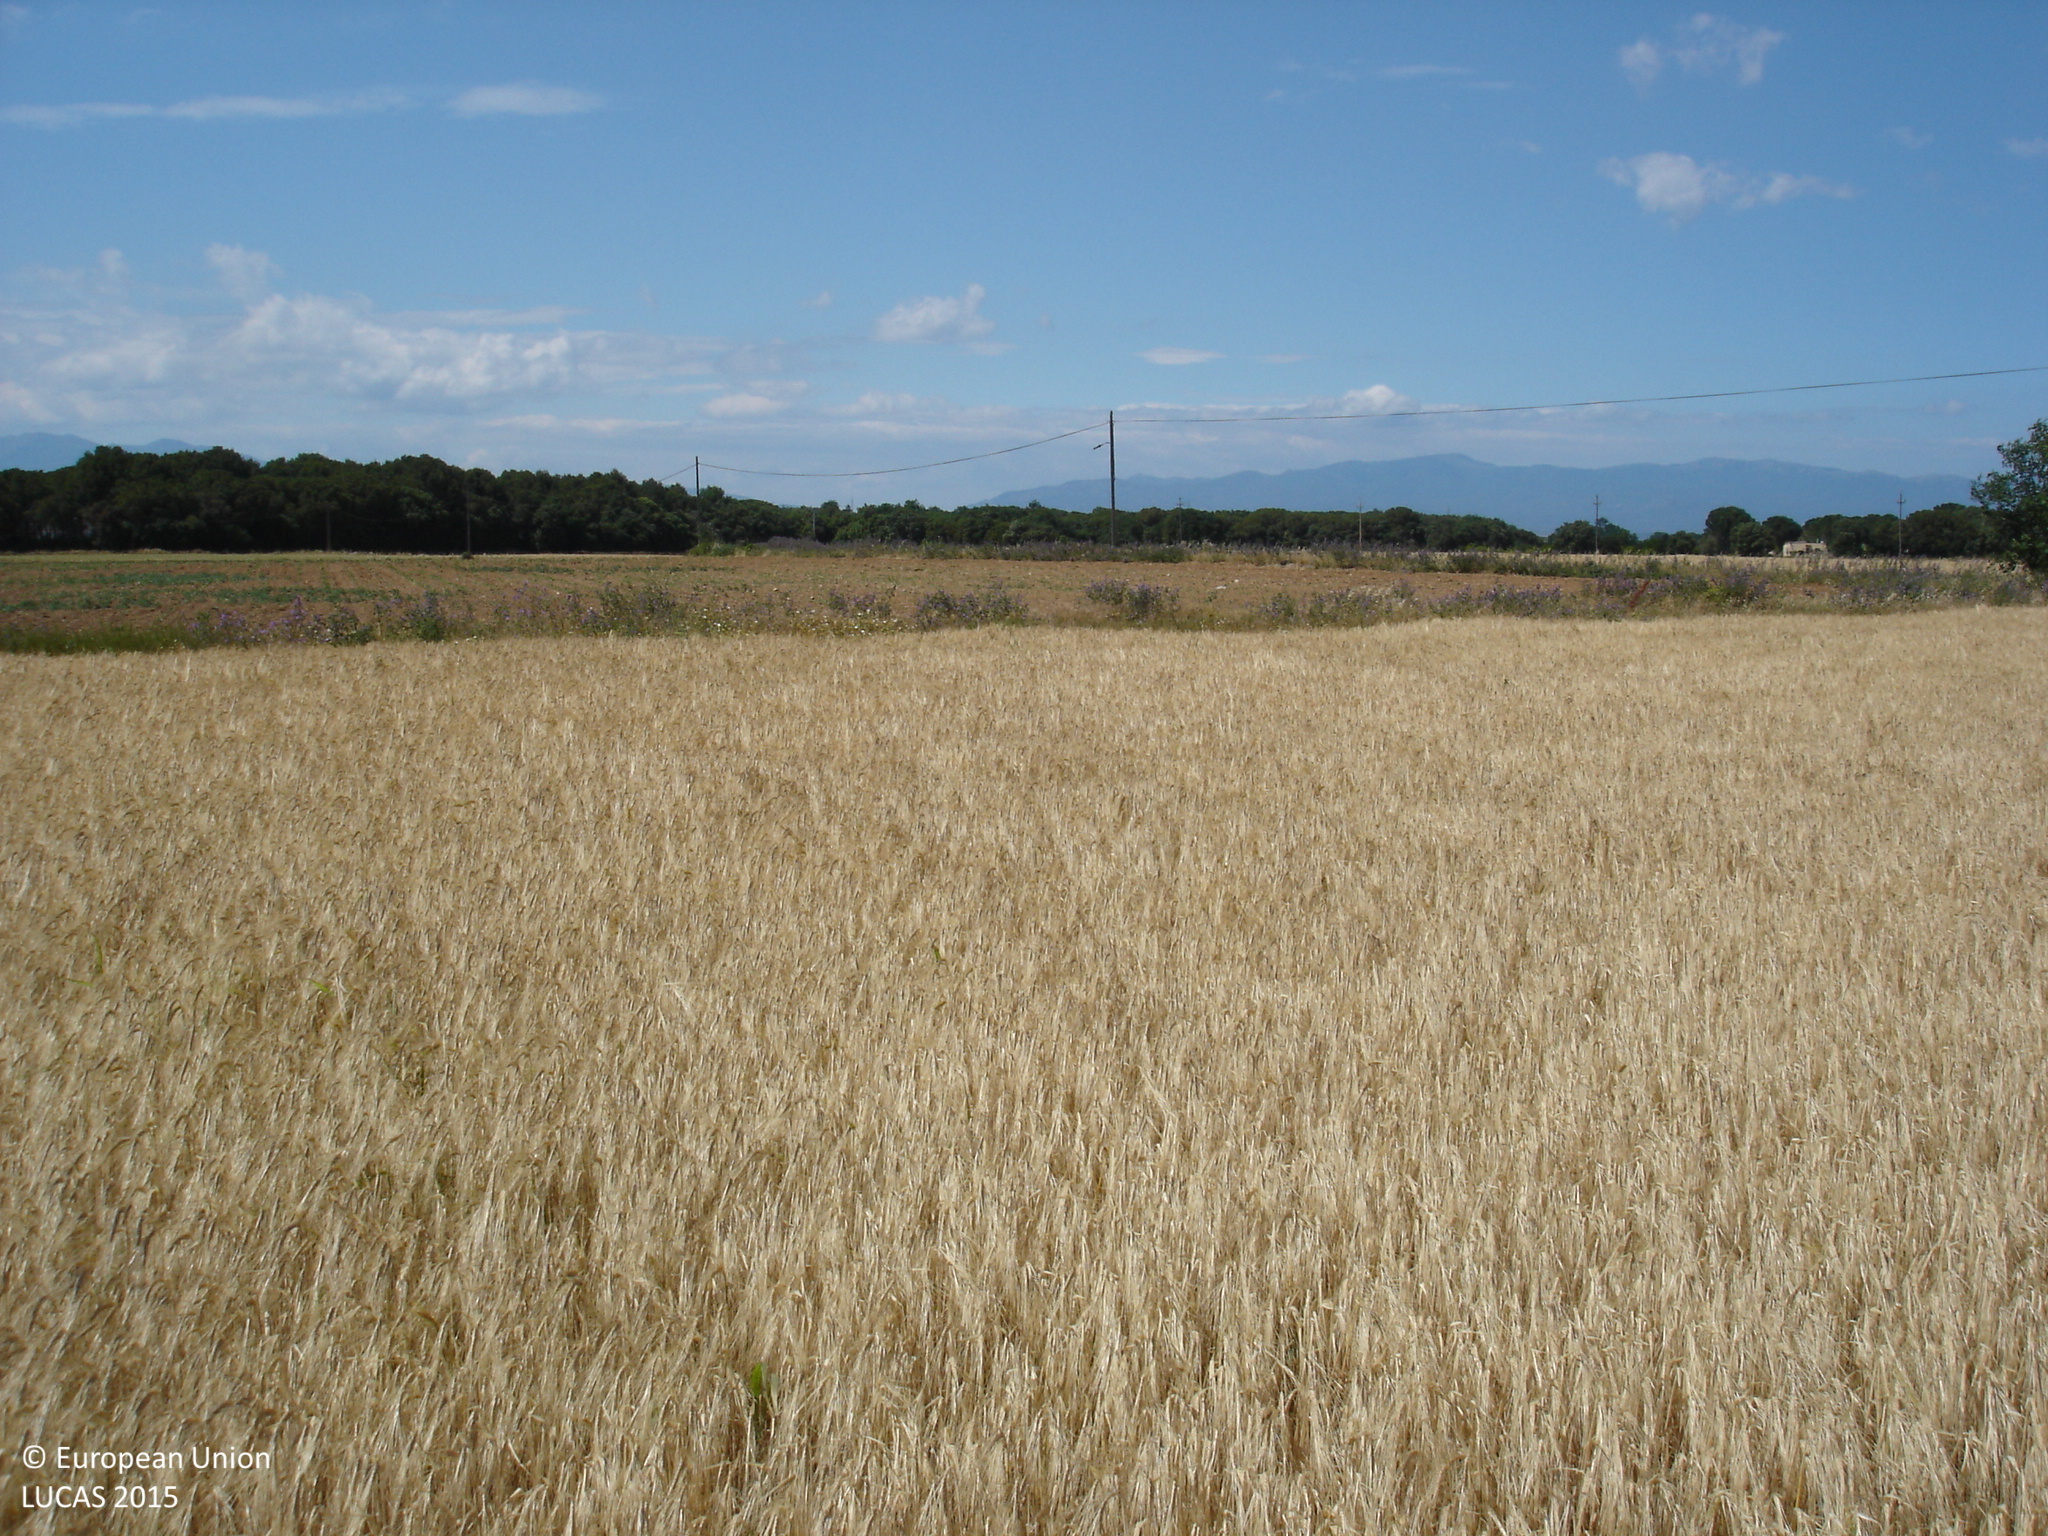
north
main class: Cropland
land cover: Barley
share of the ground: > 75 %
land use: Agriculture (excluding fallow land and kitchen gardens)
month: May
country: ES
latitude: 42.1927
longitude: 2.9791
